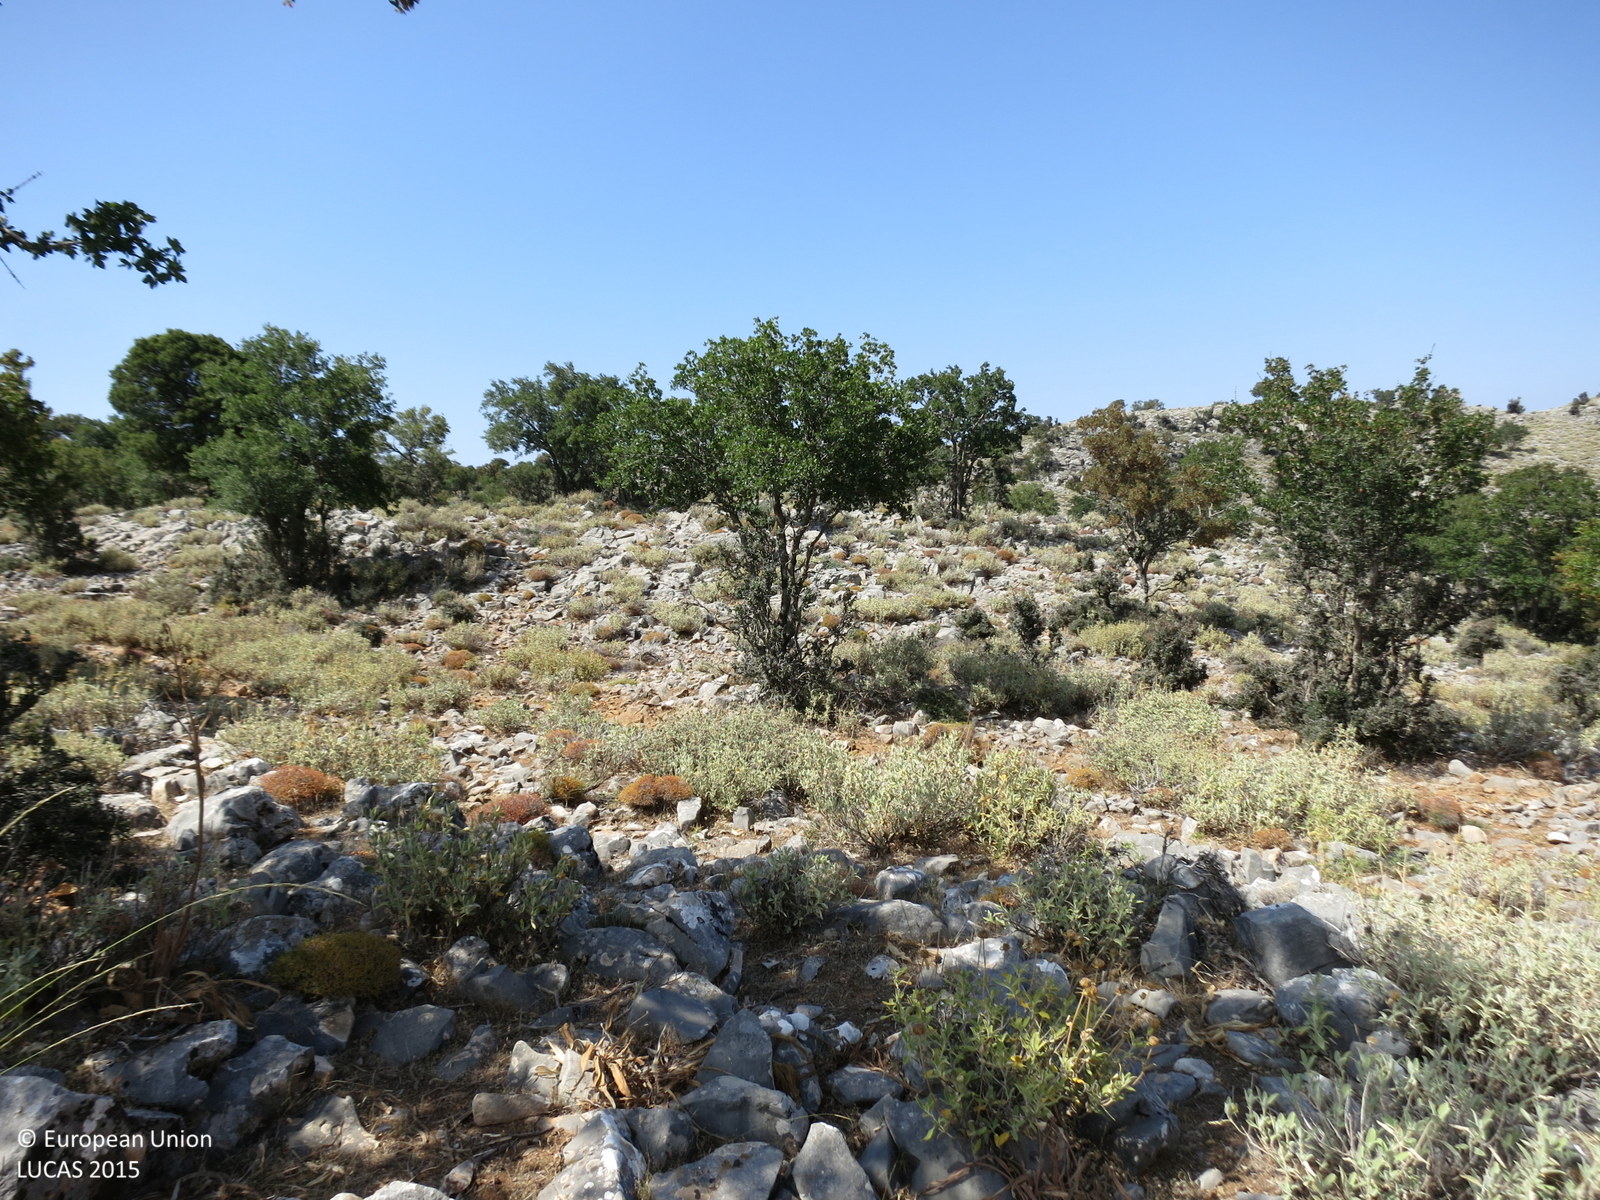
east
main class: Shrubland
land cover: Shrubland with sparse tree cover
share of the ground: 50 - 75 %
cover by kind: shrubs 55 %, unconsolidated bare surface 40 %, broadleaved forest trees 5 %
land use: Agriculture (excluding fallow land and kitchen gardens)
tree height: < 5 m
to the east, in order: Shrubland with sparse tree cover; Rock outcrops; Shrubland with sparse tree cover; Rock outcrops; Shrubland with sparse tree cover; Rock outcrops; Shrubland with sparse tree cover
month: July
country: GR
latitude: 35.2753
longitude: 24.7971
